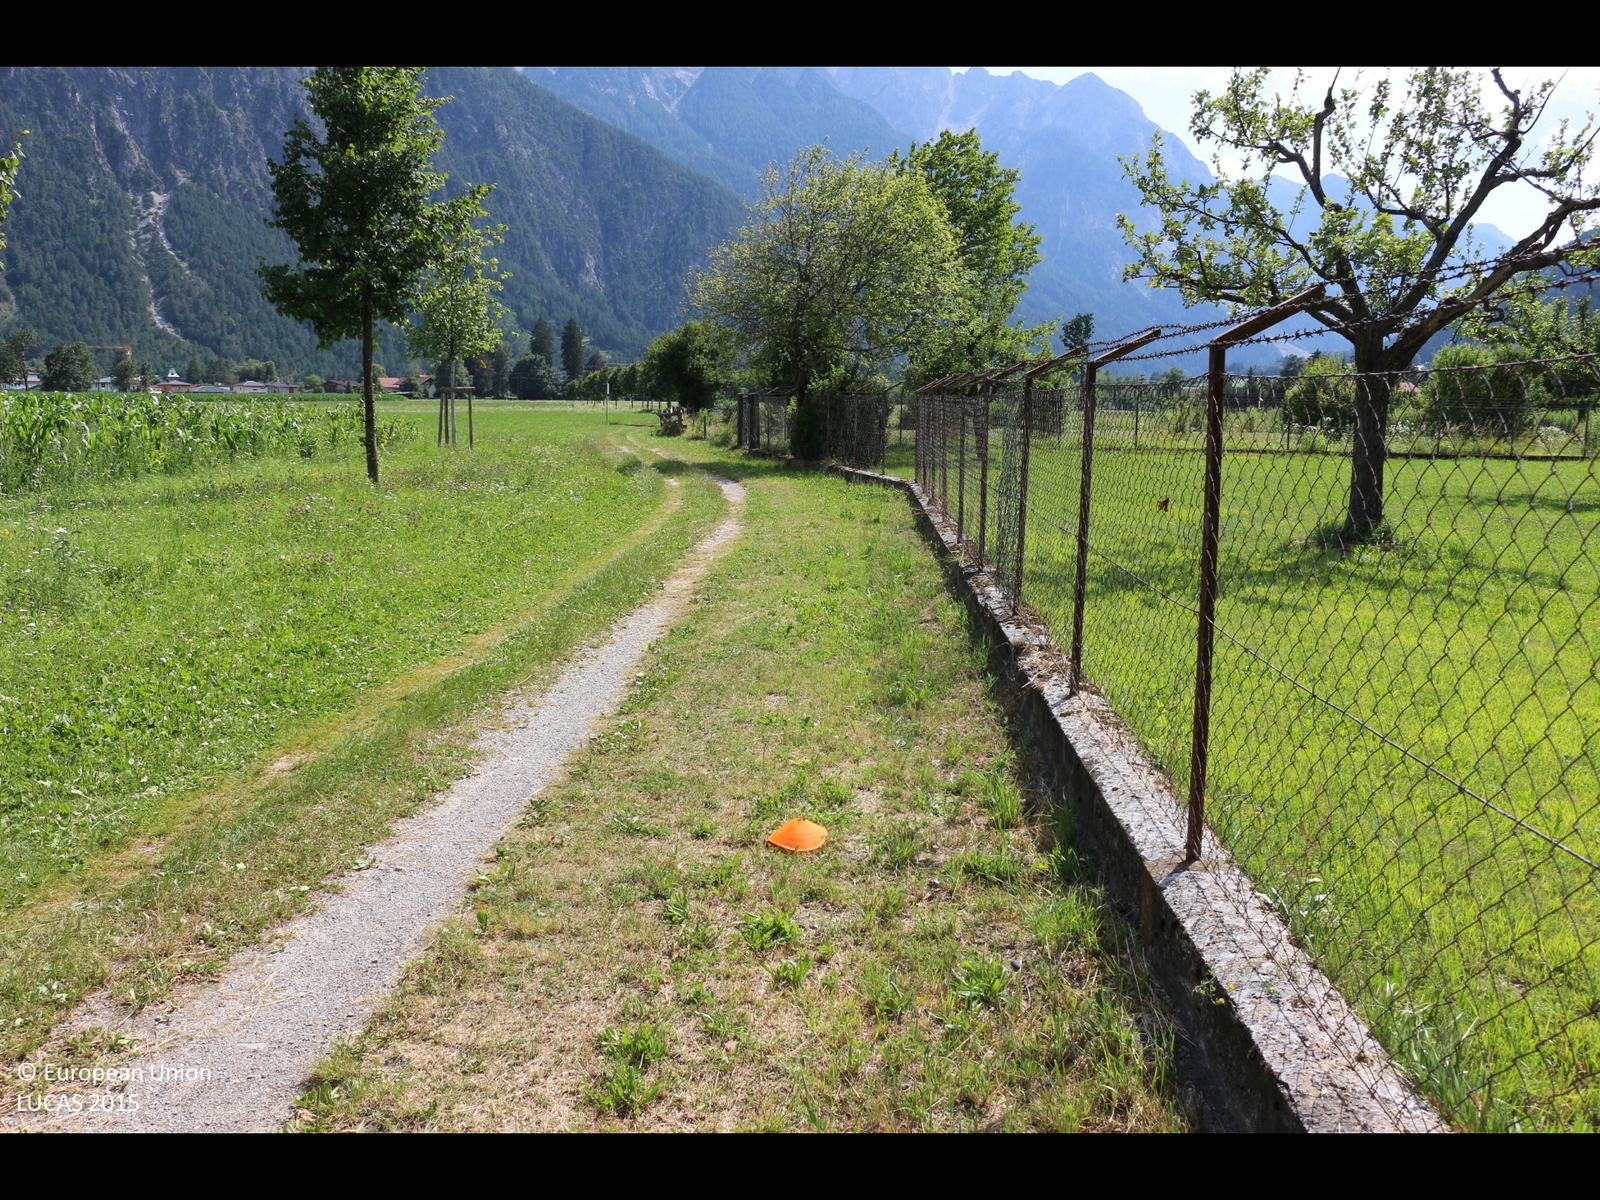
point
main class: Grassland
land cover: Grassland without tree/shrub cover
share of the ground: > 75 %
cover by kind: herbaceous plants 100 %
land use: Agriculture (excluding fallow land and kitchen gardens)
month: July
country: AT
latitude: 46.8201
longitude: 12.7632
